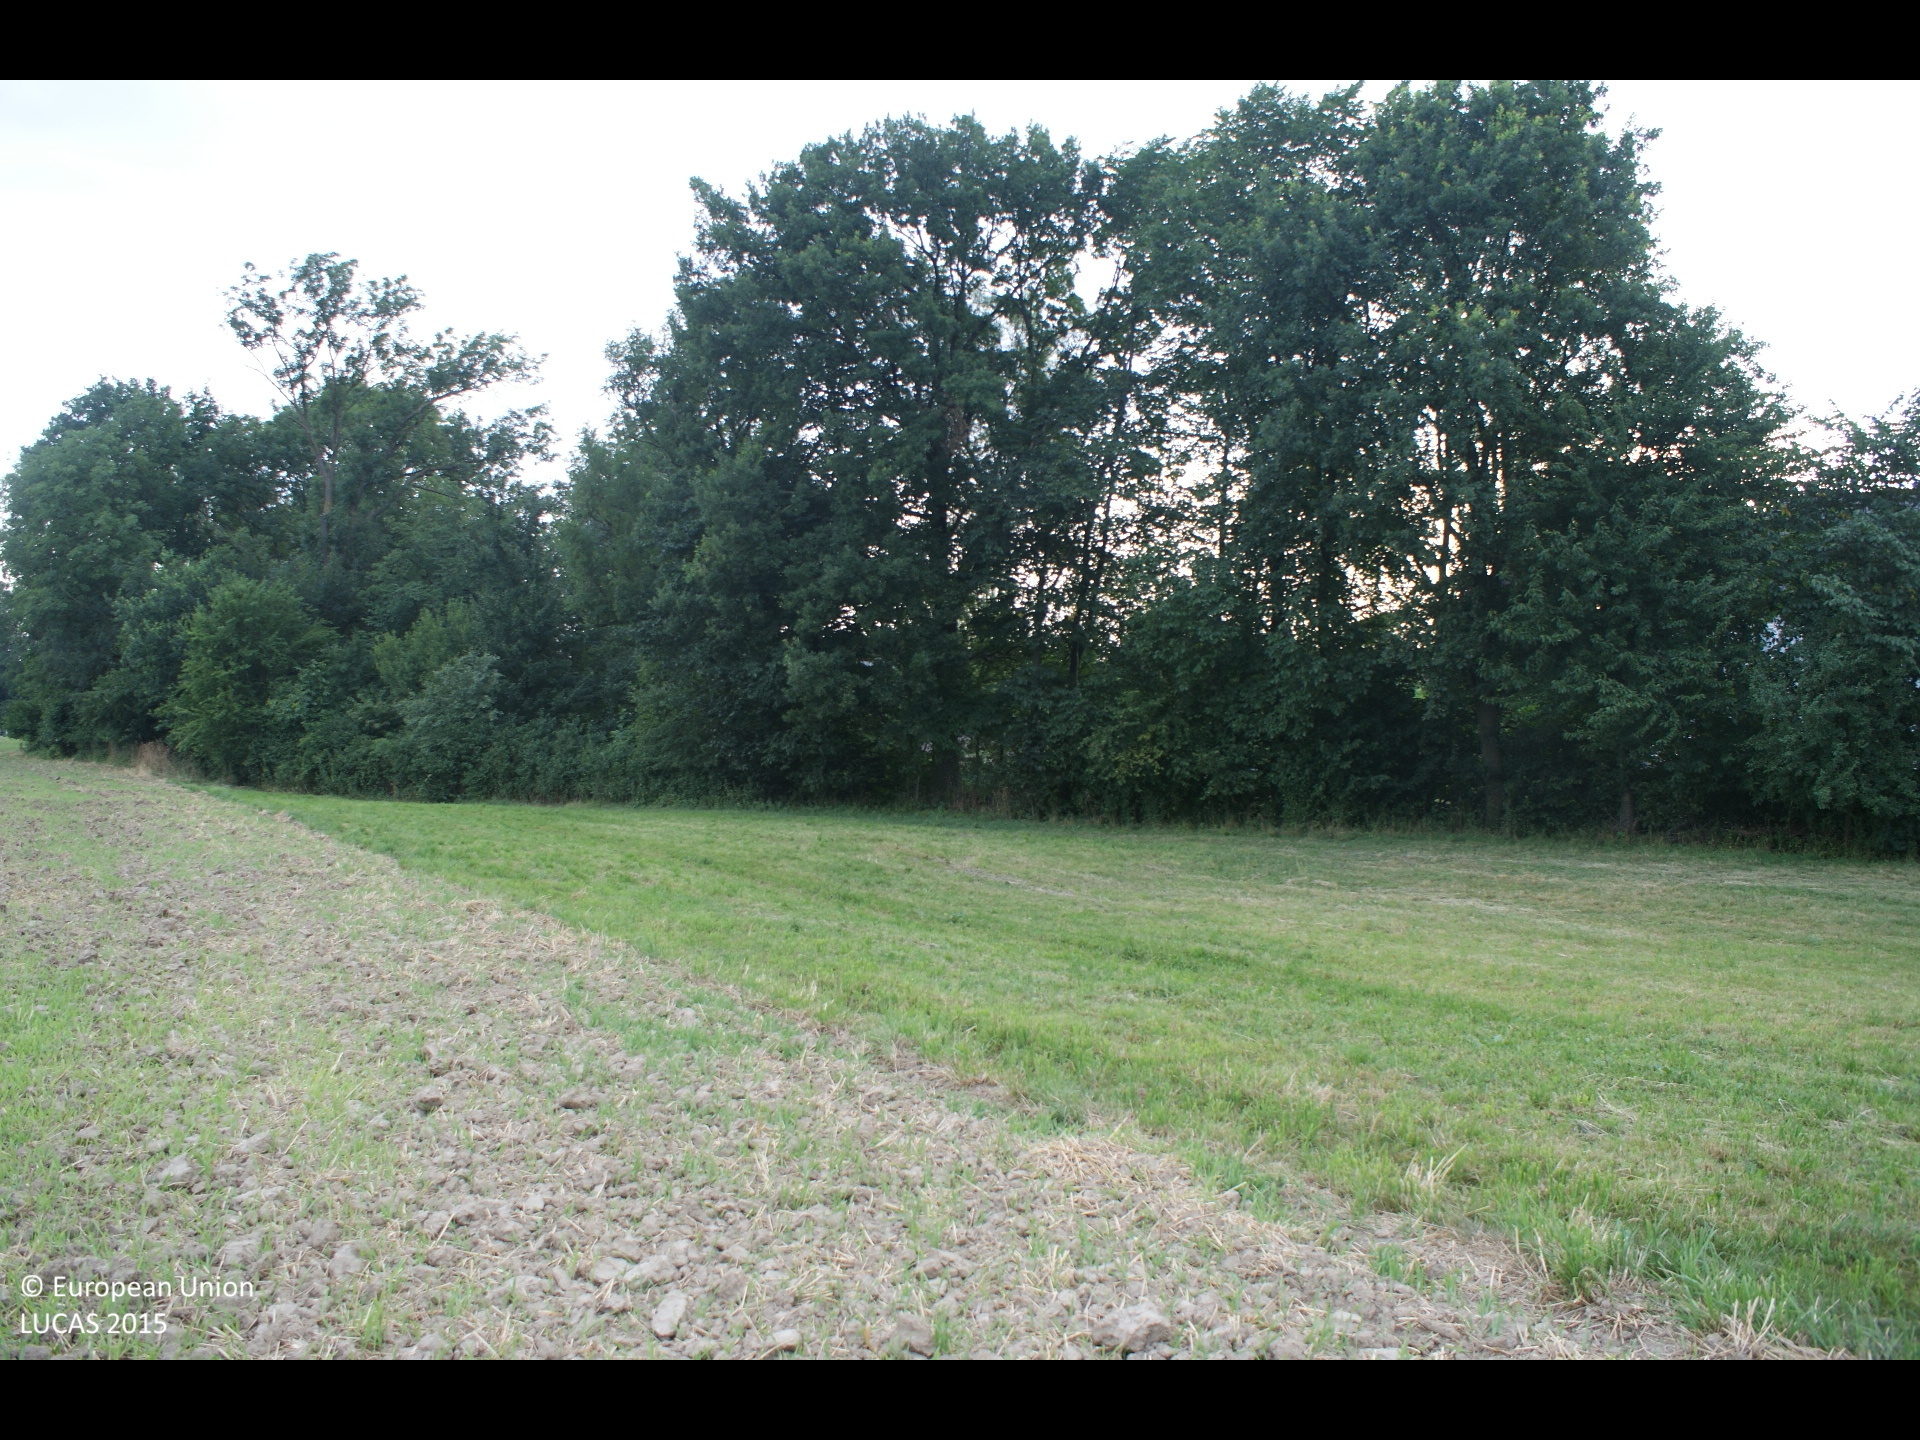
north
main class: Cropland
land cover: Temporary grasslands
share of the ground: 10 - 25 %
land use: Agriculture (excluding fallow land and kitchen gardens)
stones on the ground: < 10 %
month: July
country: AT
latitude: 48.0932
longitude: 15.3590
